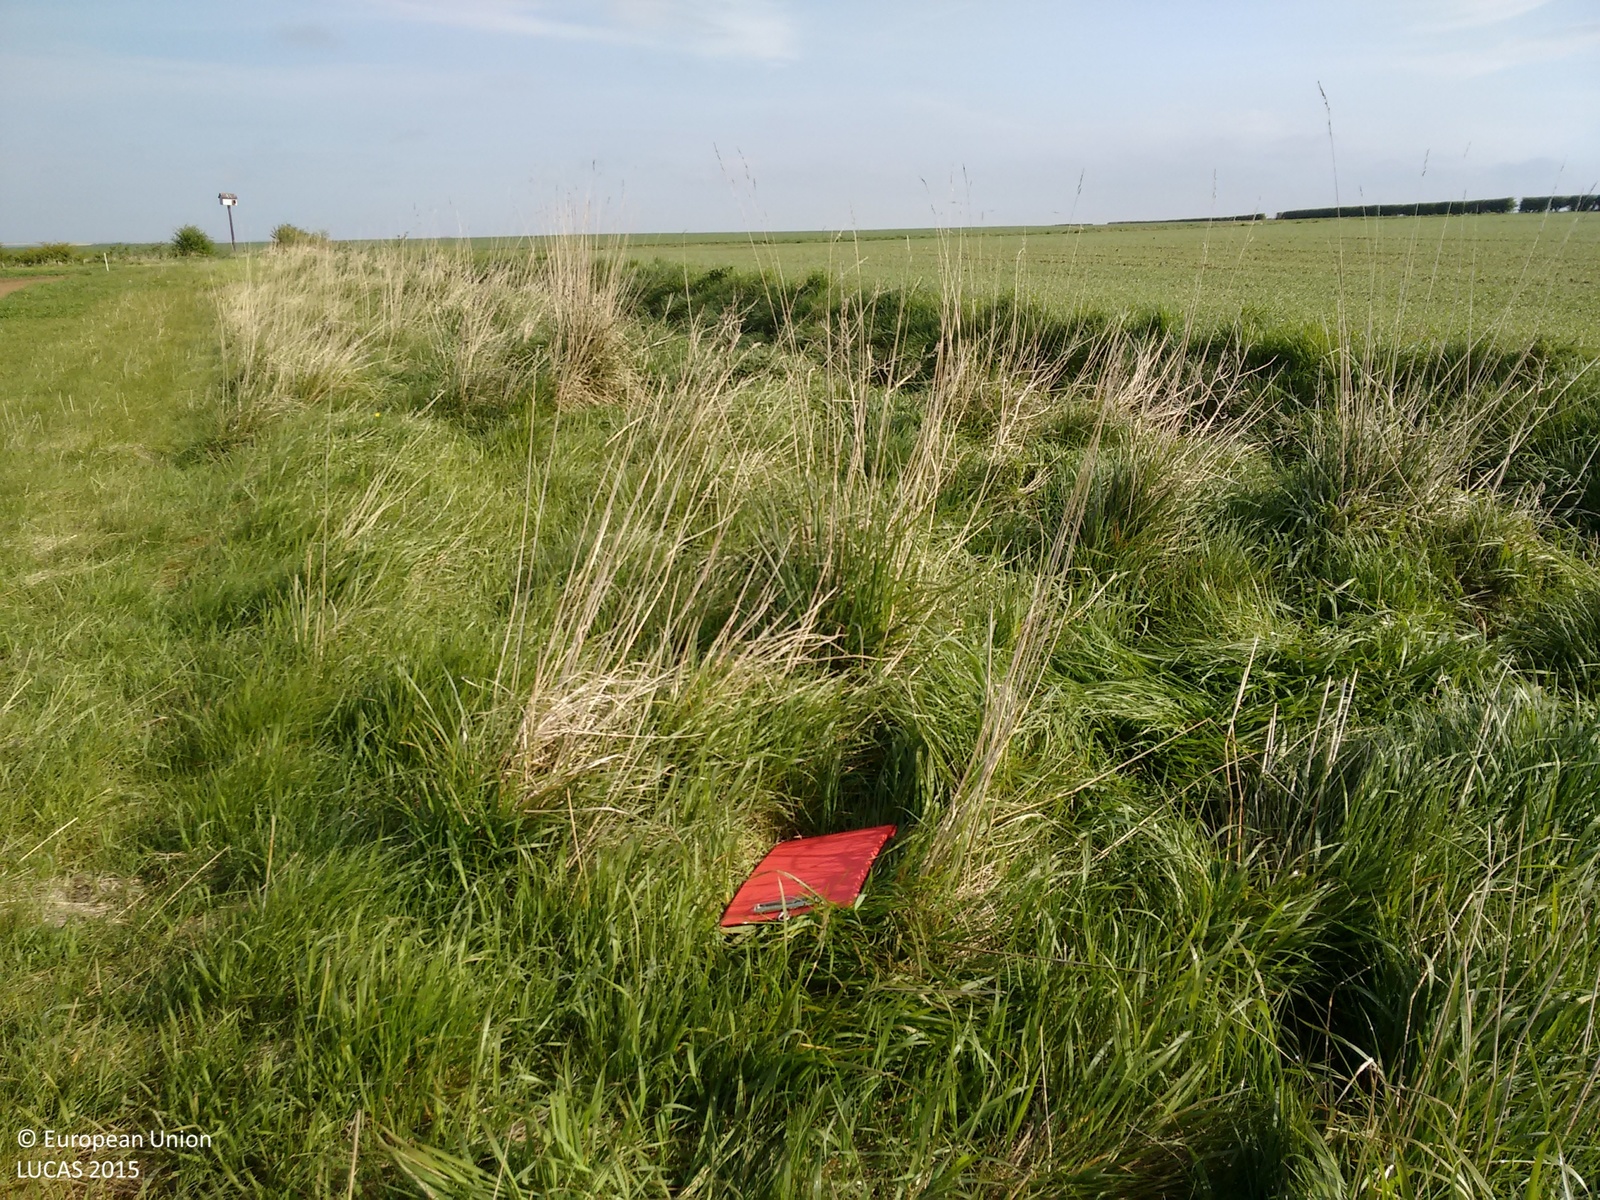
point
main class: Grassland
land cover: Grassland without tree/shrub cover
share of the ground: > 75 %
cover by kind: herbaceous plants 100 %
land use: Agriculture (excluding fallow land and kitchen gardens)
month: May
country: GB
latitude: 53.9924
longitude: -0.3303
